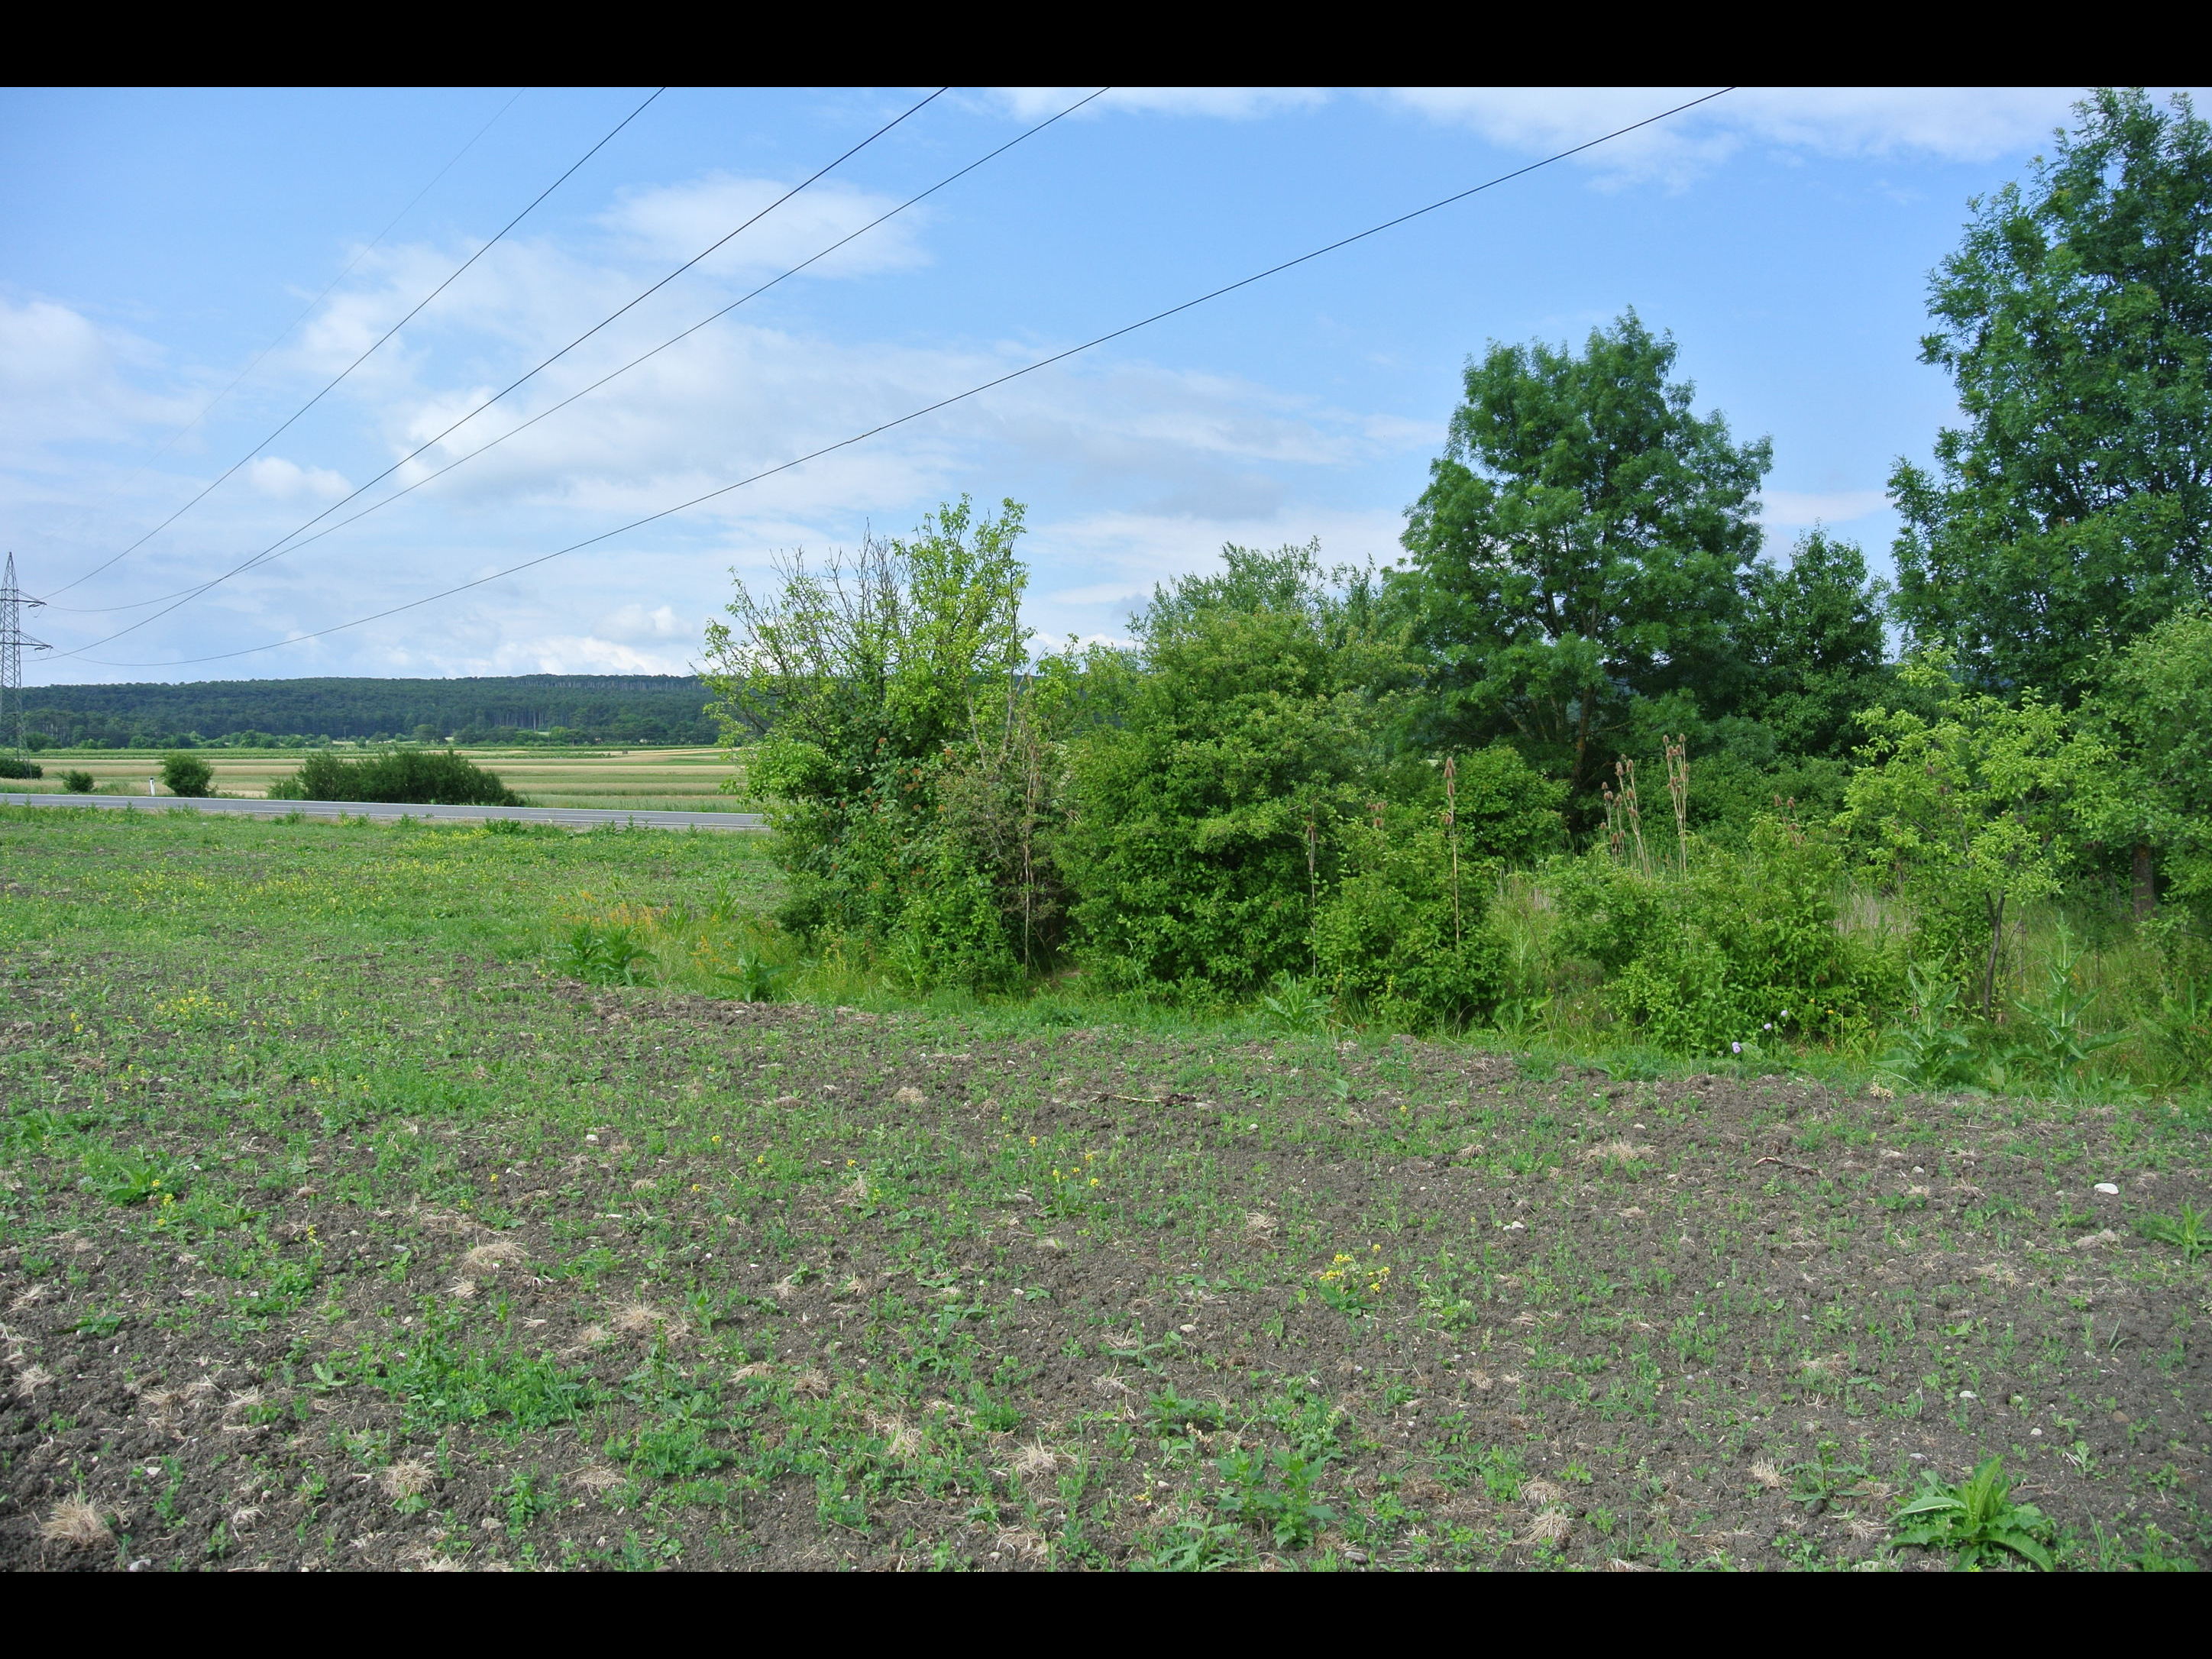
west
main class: Grassland
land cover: Spontaneously vegetated surfaces
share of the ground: 25 - 50 %
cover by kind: unconsolidated bare surface 55 %, herbaceous plants 45 %
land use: Agriculture (excluding fallow land and kitchen gardens)
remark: Harvested field
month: June
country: AT
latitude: 47.9048
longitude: 16.1978
